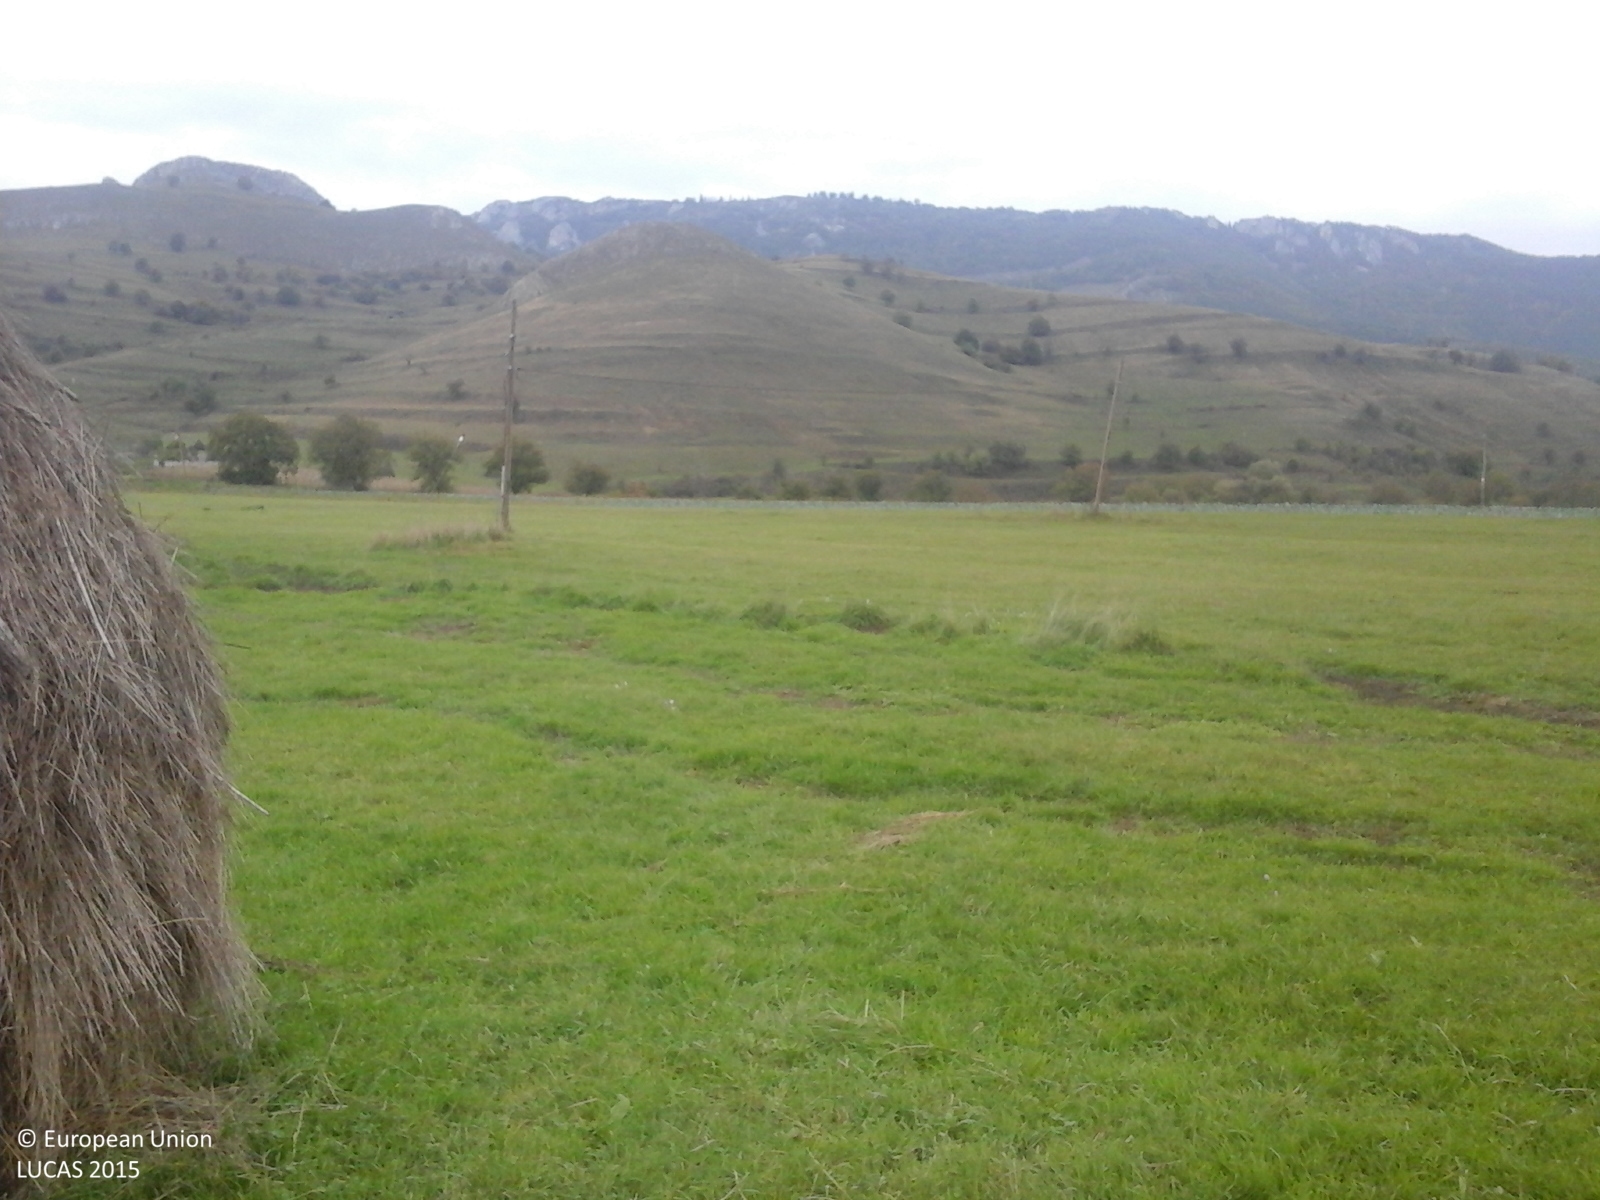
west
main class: Grassland
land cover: Grassland without tree/shrub cover
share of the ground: > 75 %
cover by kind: herbaceous plants 100 %
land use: Agriculture (excluding fallow land and kitchen gardens)
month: October
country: RO
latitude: 46.4315
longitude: 23.5639
